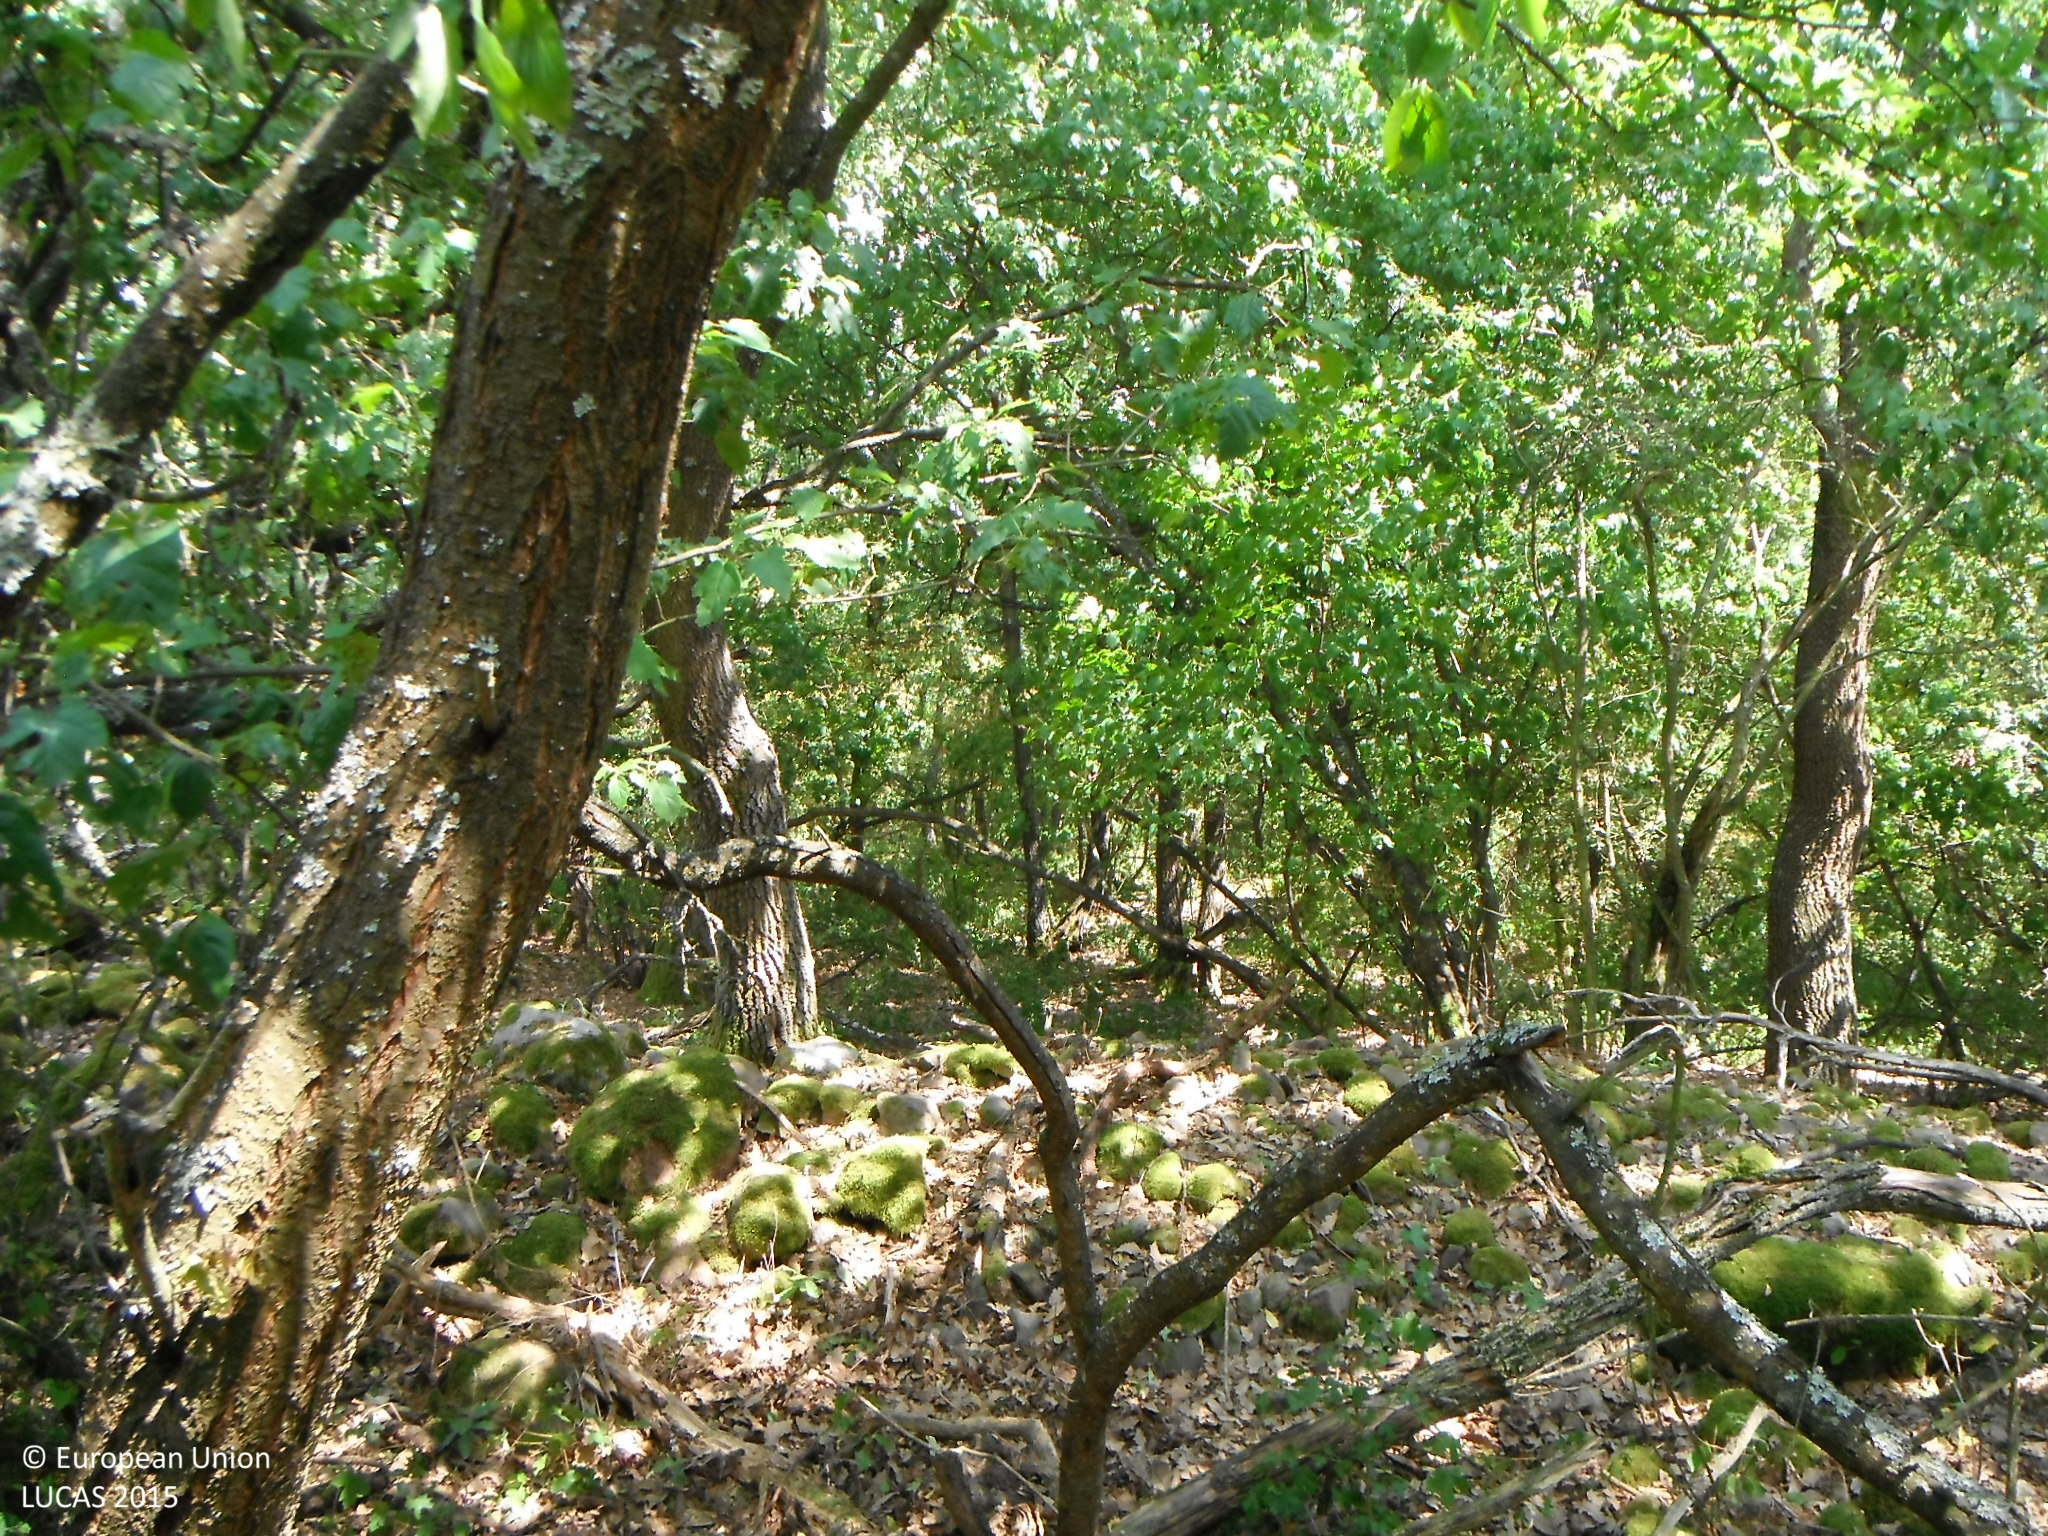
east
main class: Woodland
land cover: Broadleaved woodland
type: thermophilous deciduous forest
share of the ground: > 75 %
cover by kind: broadleaved forest trees 90 %, shrubs 10 %
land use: Forestry
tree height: > 5 m
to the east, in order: Broadleaved woodland
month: July
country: SK
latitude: 48.2193
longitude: 18.9703
